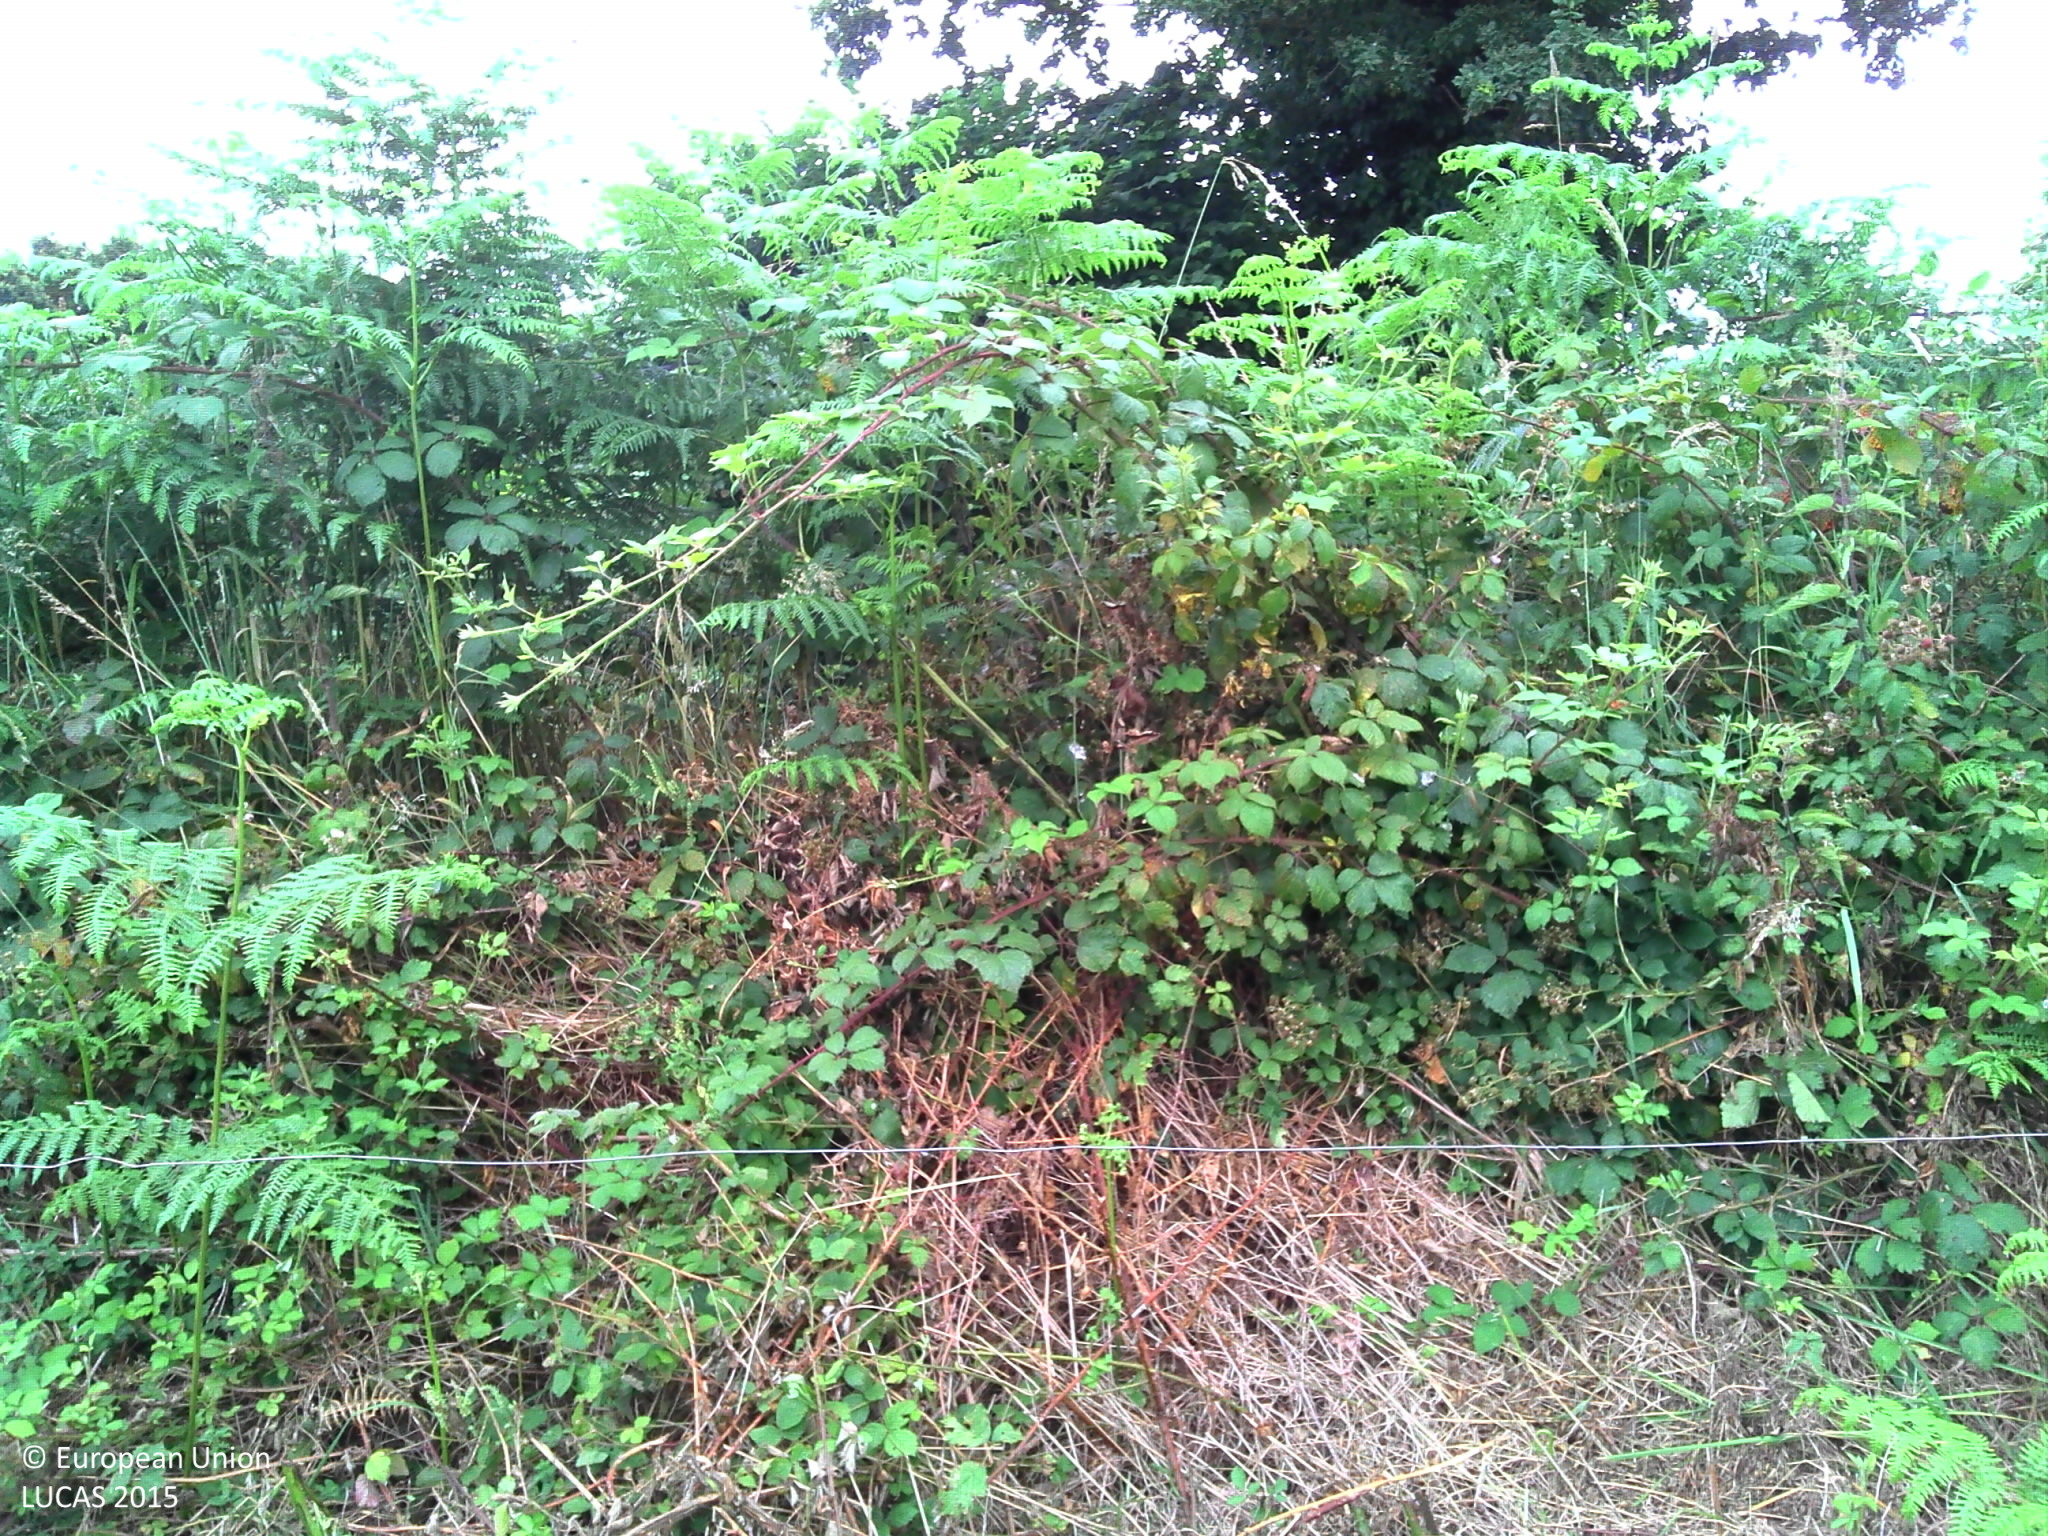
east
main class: Grassland
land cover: Grassland without tree/shrub cover
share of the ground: > 75 %
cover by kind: herbaceous plants 100 %
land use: Agriculture (excluding fallow land and kitchen gardens)
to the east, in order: Managed hedges; Ditches and canals; Grass margins; Electric lines; Paved roads, cycling and walking lanes; Grass margins; Ditches and canals; Electric lines; Managed hedges; Grassland without tree/shrub cover; Broadleaved woodland; Grassland without tree/shrub cover; Broadleaved woodland; Grassland without tree/shrub cover; Electric lines; Grassland without tree/shrub cover
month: July
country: FR
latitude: 48.1196
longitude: -3.6343
